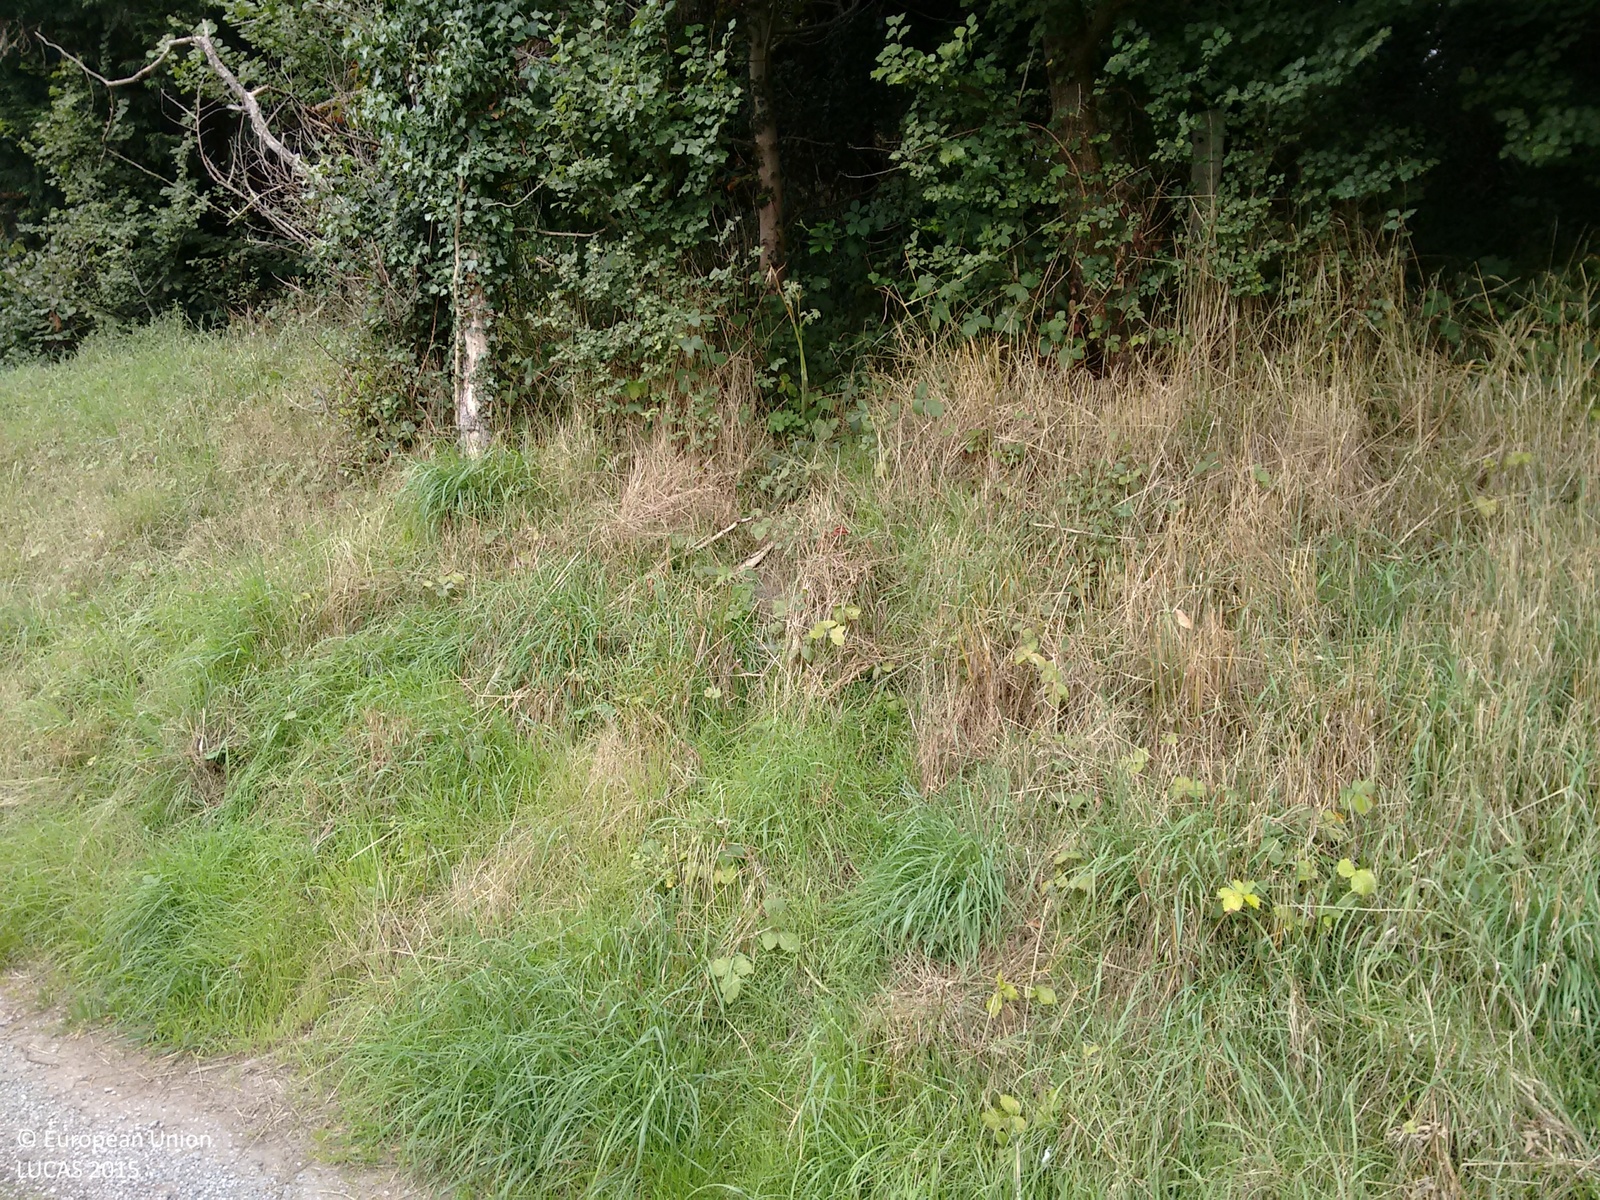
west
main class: Grassland
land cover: Grassland without tree/shrub cover
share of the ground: > 75 %
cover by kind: herbaceous plants 100 %
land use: Agriculture (excluding fallow land and kitchen gardens)
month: September
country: GB
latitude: 52.7990
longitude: -2.9025
